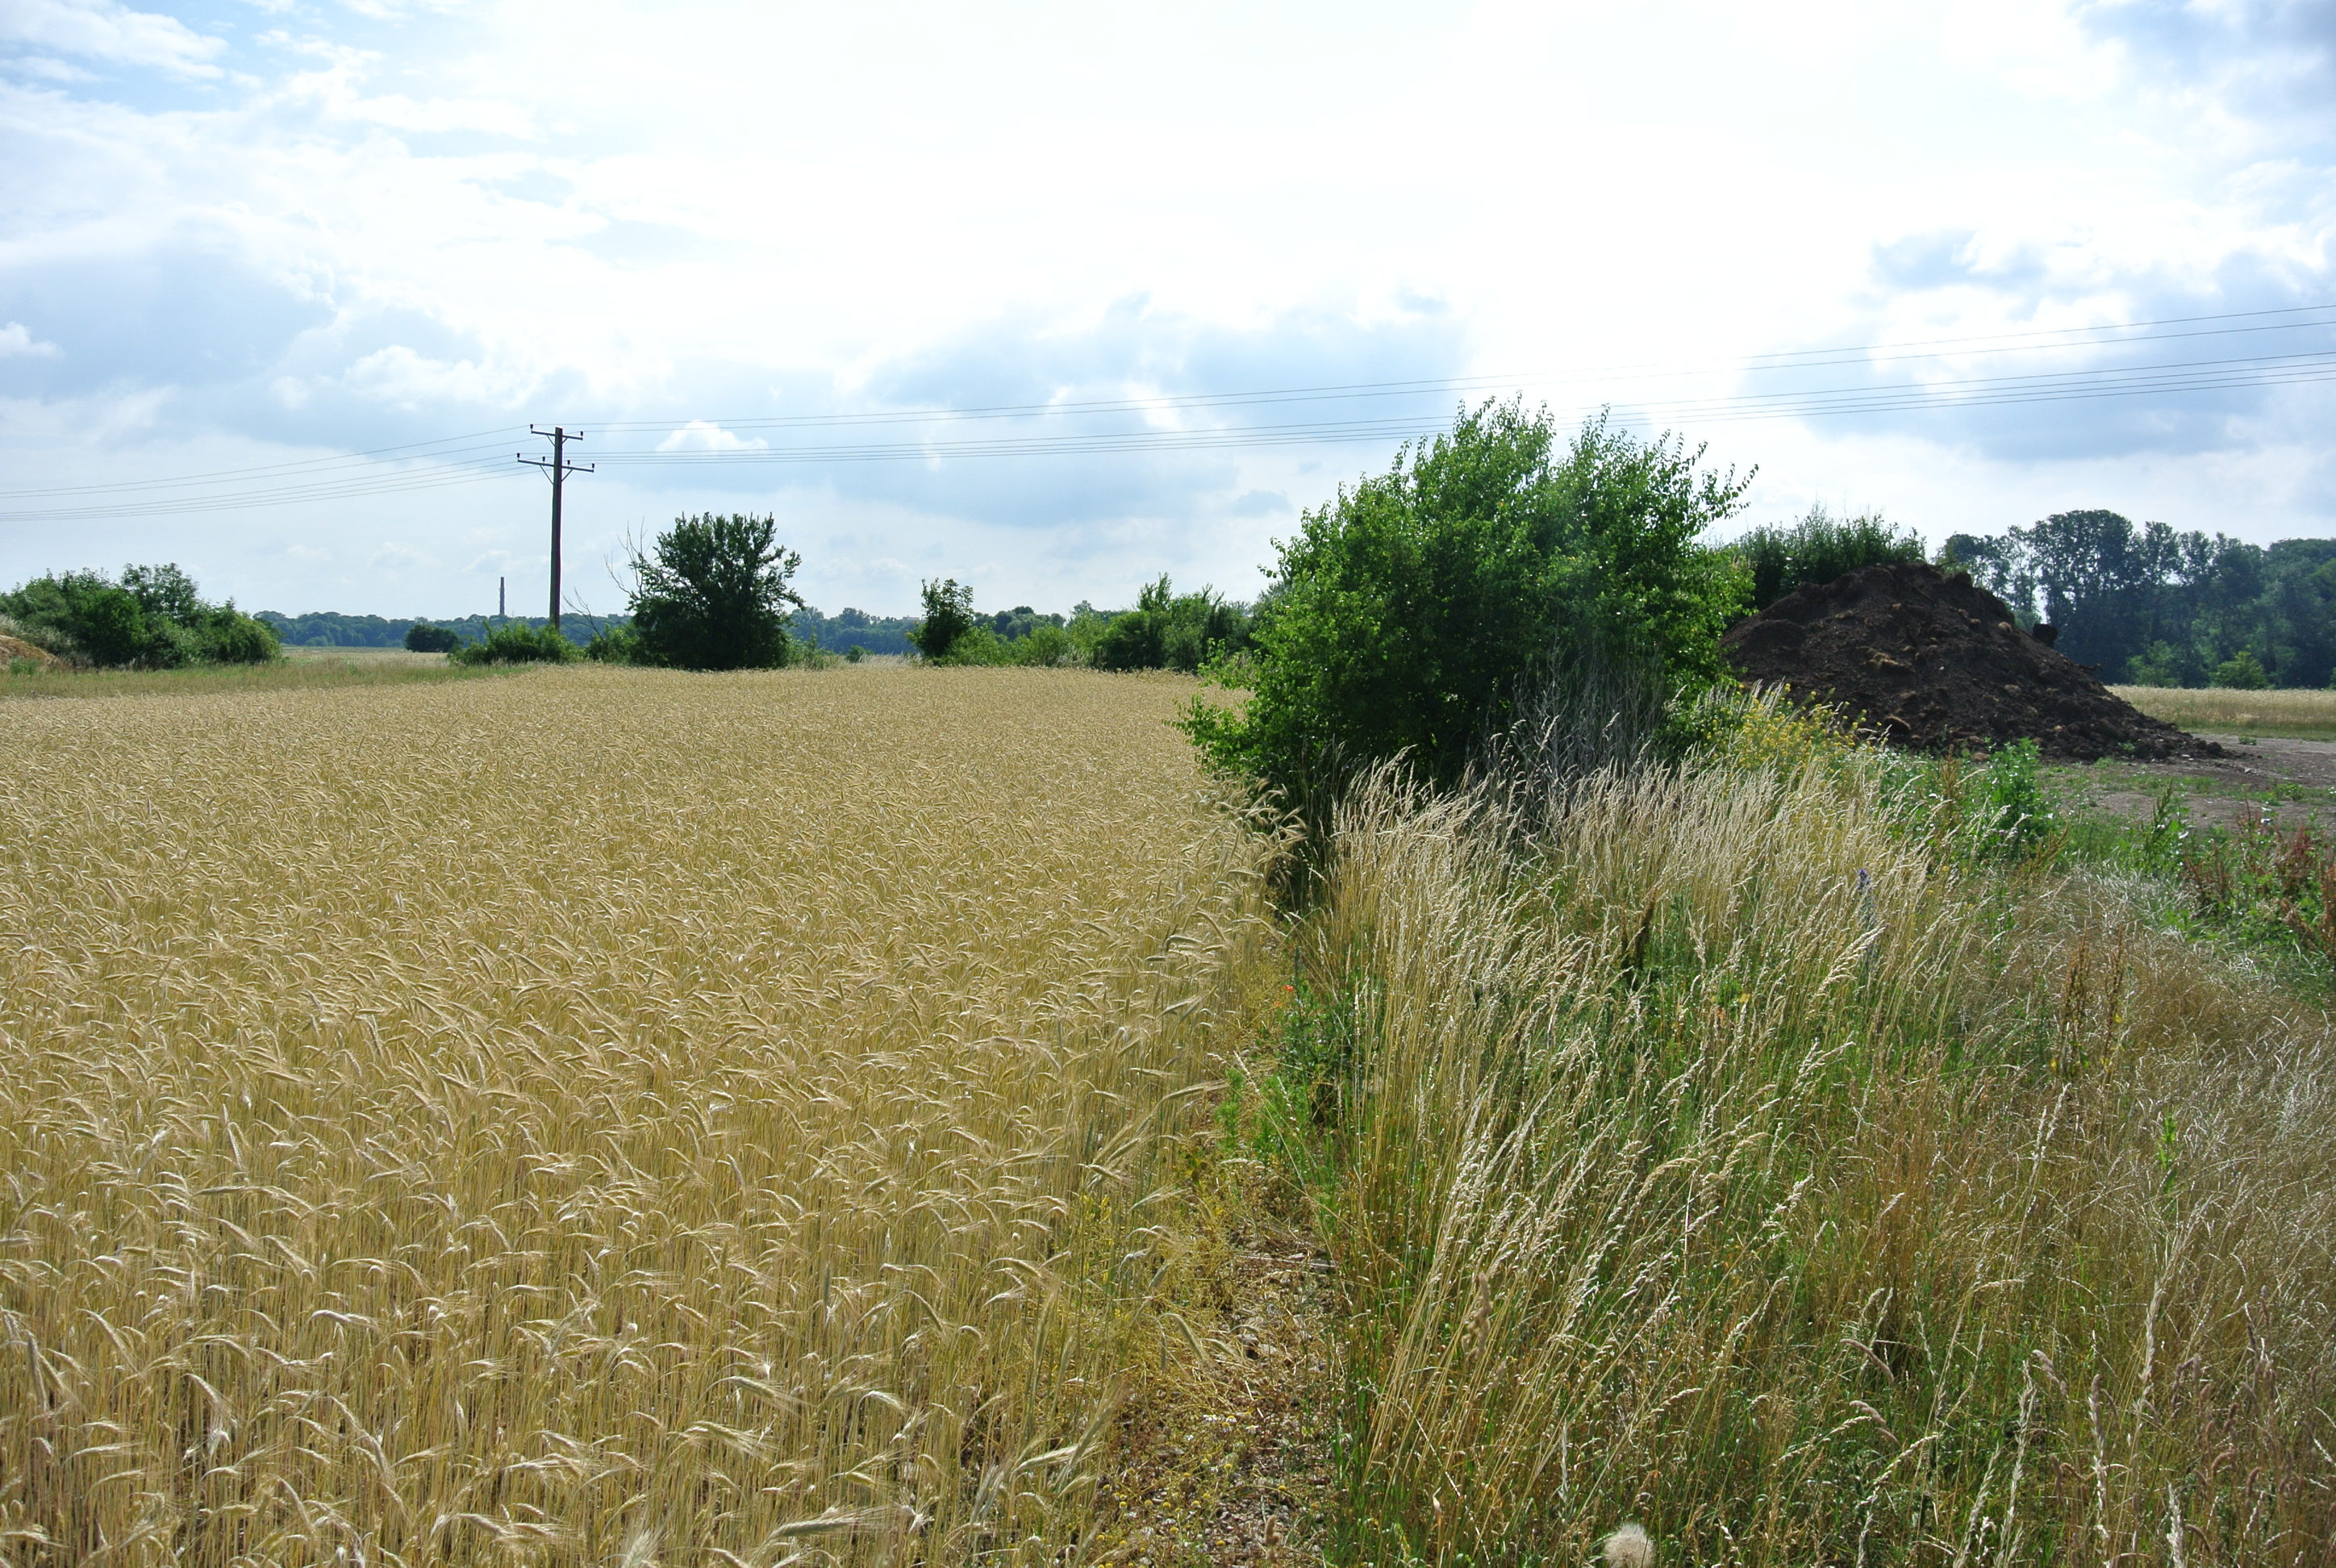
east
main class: Cropland
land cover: Barley
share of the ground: > 75 %
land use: Agriculture (excluding fallow land and kitchen gardens)
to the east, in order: Barley; Shrubland with sparse tree cover; Electric lines; Tracks; Grass margins; Barley; Tracks; Lucerne
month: June
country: AT
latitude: 47.8853
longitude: 16.2223
